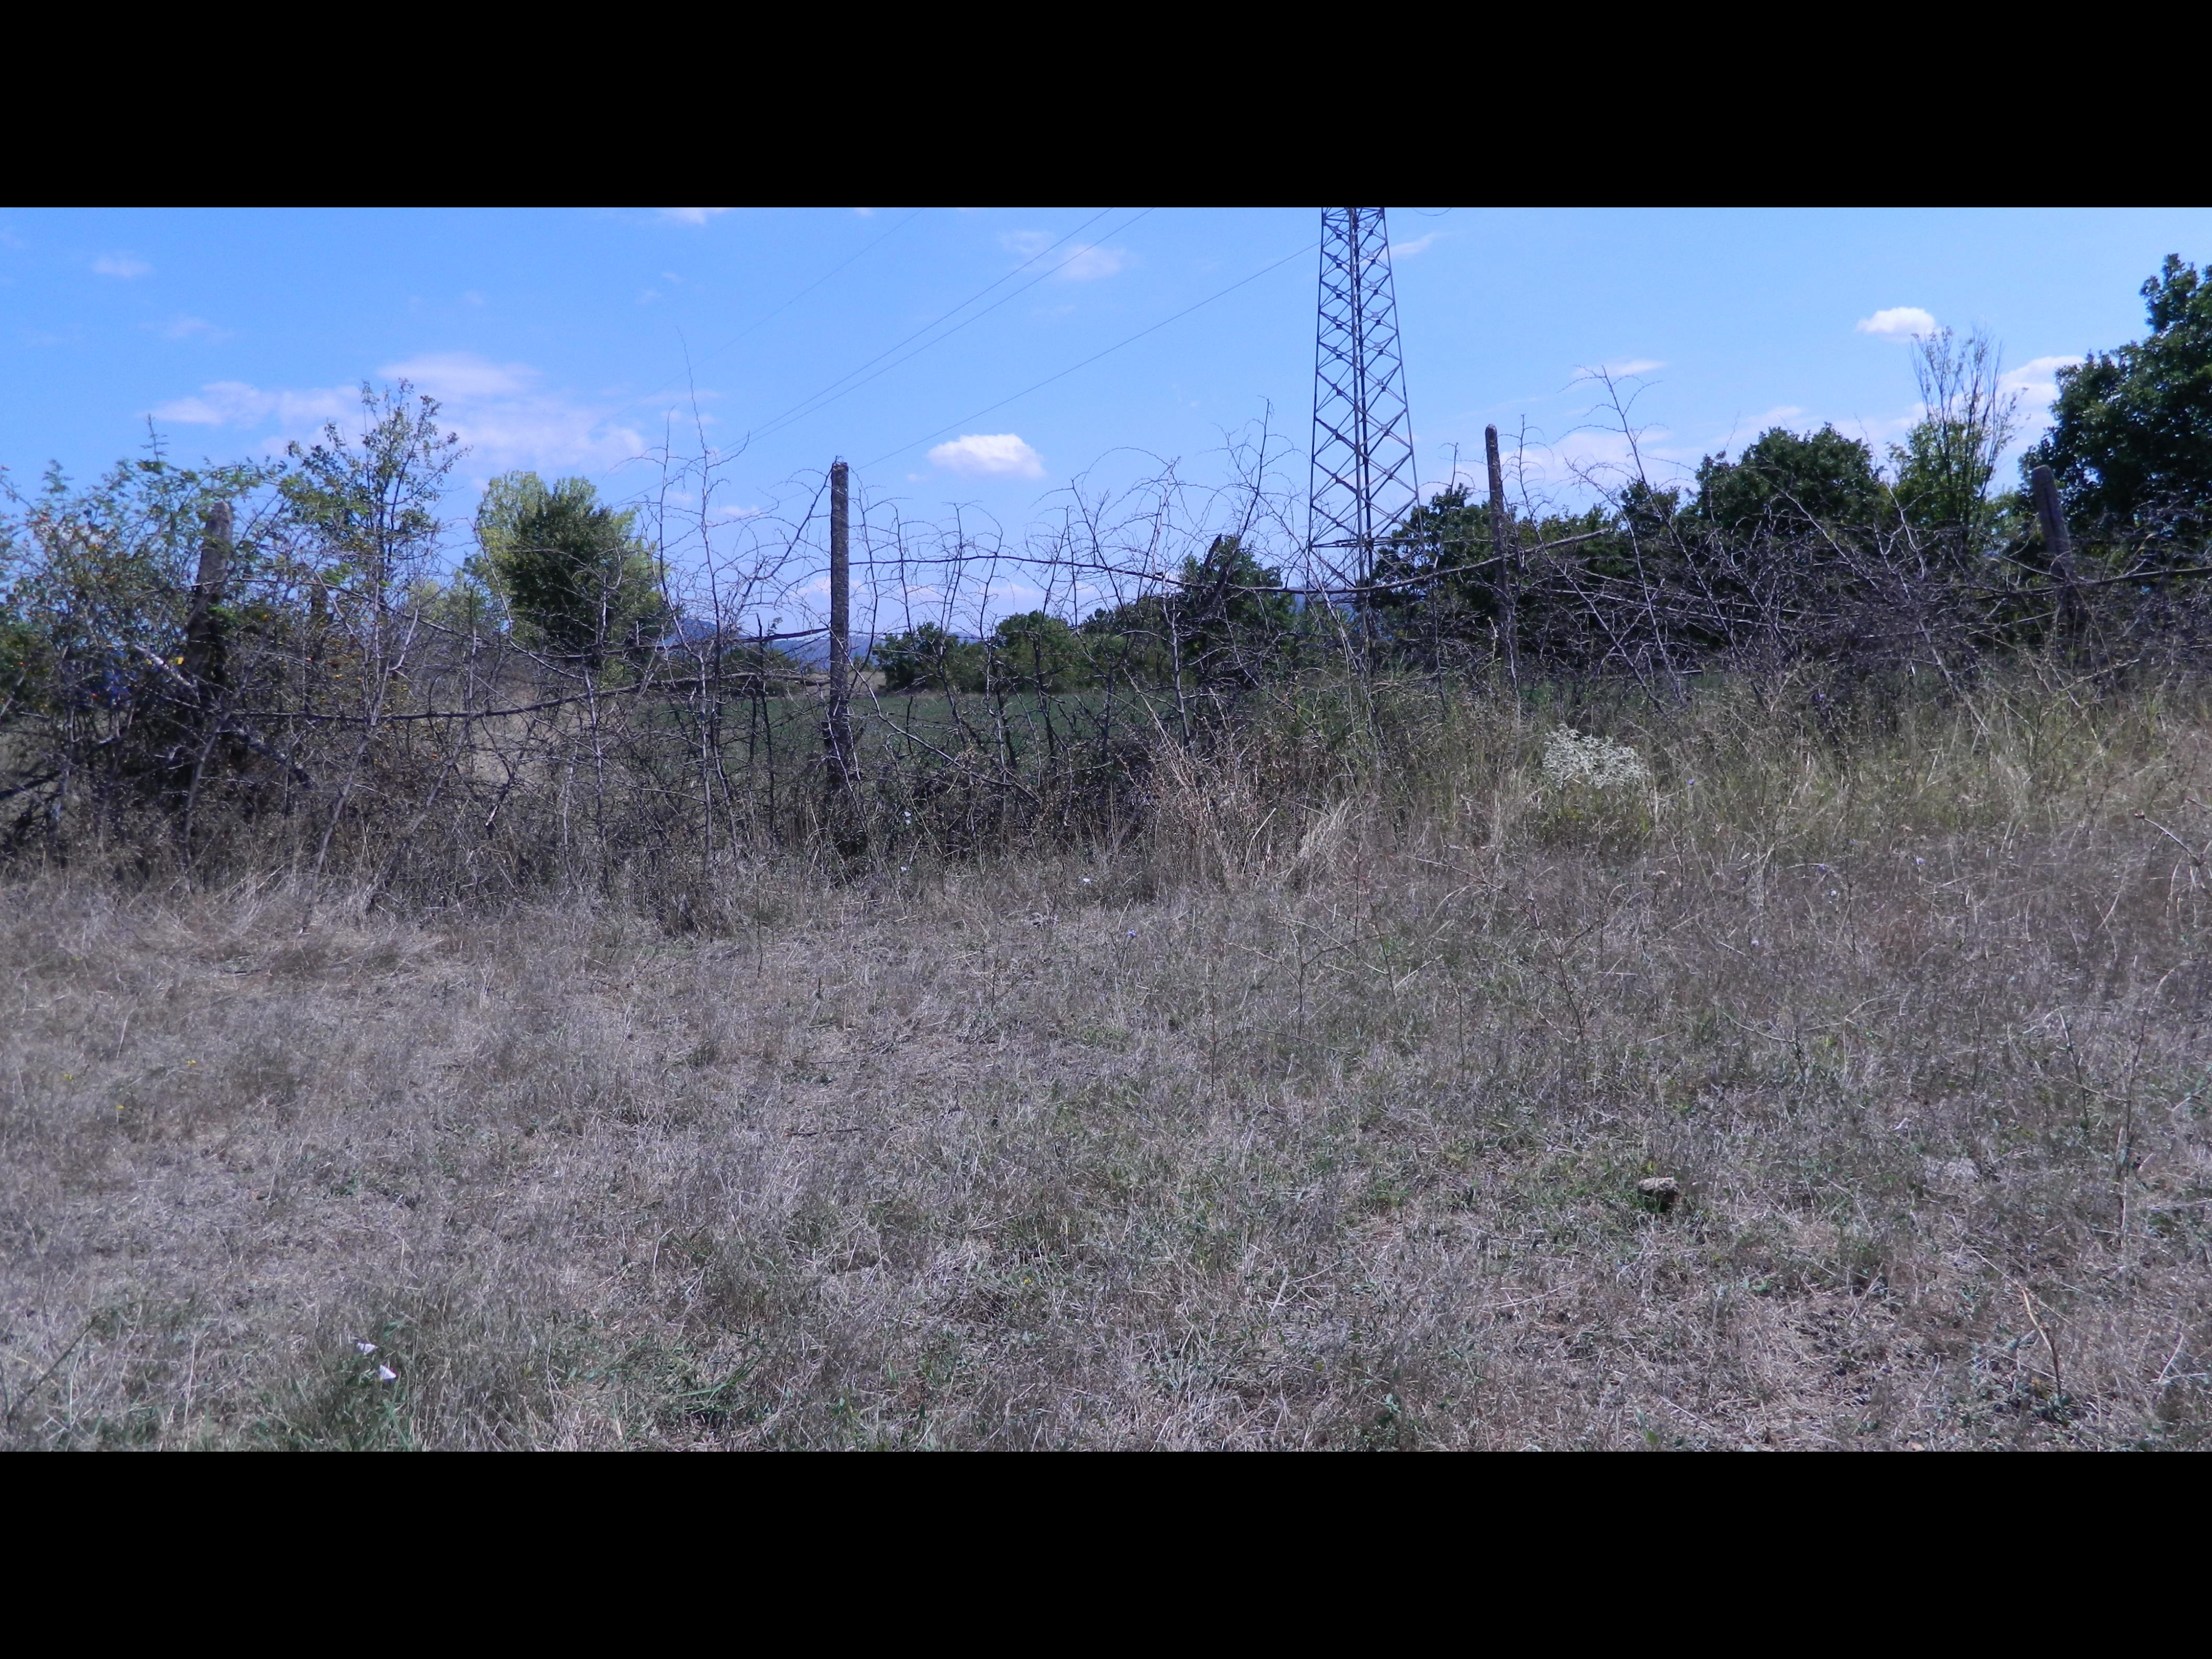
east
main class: Grassland
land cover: Grassland without tree/shrub cover
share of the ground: > 75 %
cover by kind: herbaceous plants 95 %, shrubs 5 %
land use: Agriculture (excluding fallow land and kitchen gardens)
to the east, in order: Grassland without tree/shrub cover; Fences; Lucerne; Managed hedges; Electric lines; Grassland with sparse tree/shrub cover; Tracks; Grassland without tree/shrub cover; Tracks; Grassland without tree/shrub cover; Managed hedges; Tracks; Grassland with sparse tree/shrub cover; Broadleaved woodland; Grassland with sparse tree/shrub cover
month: August
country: BG
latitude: 41.6540
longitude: 25.7347
